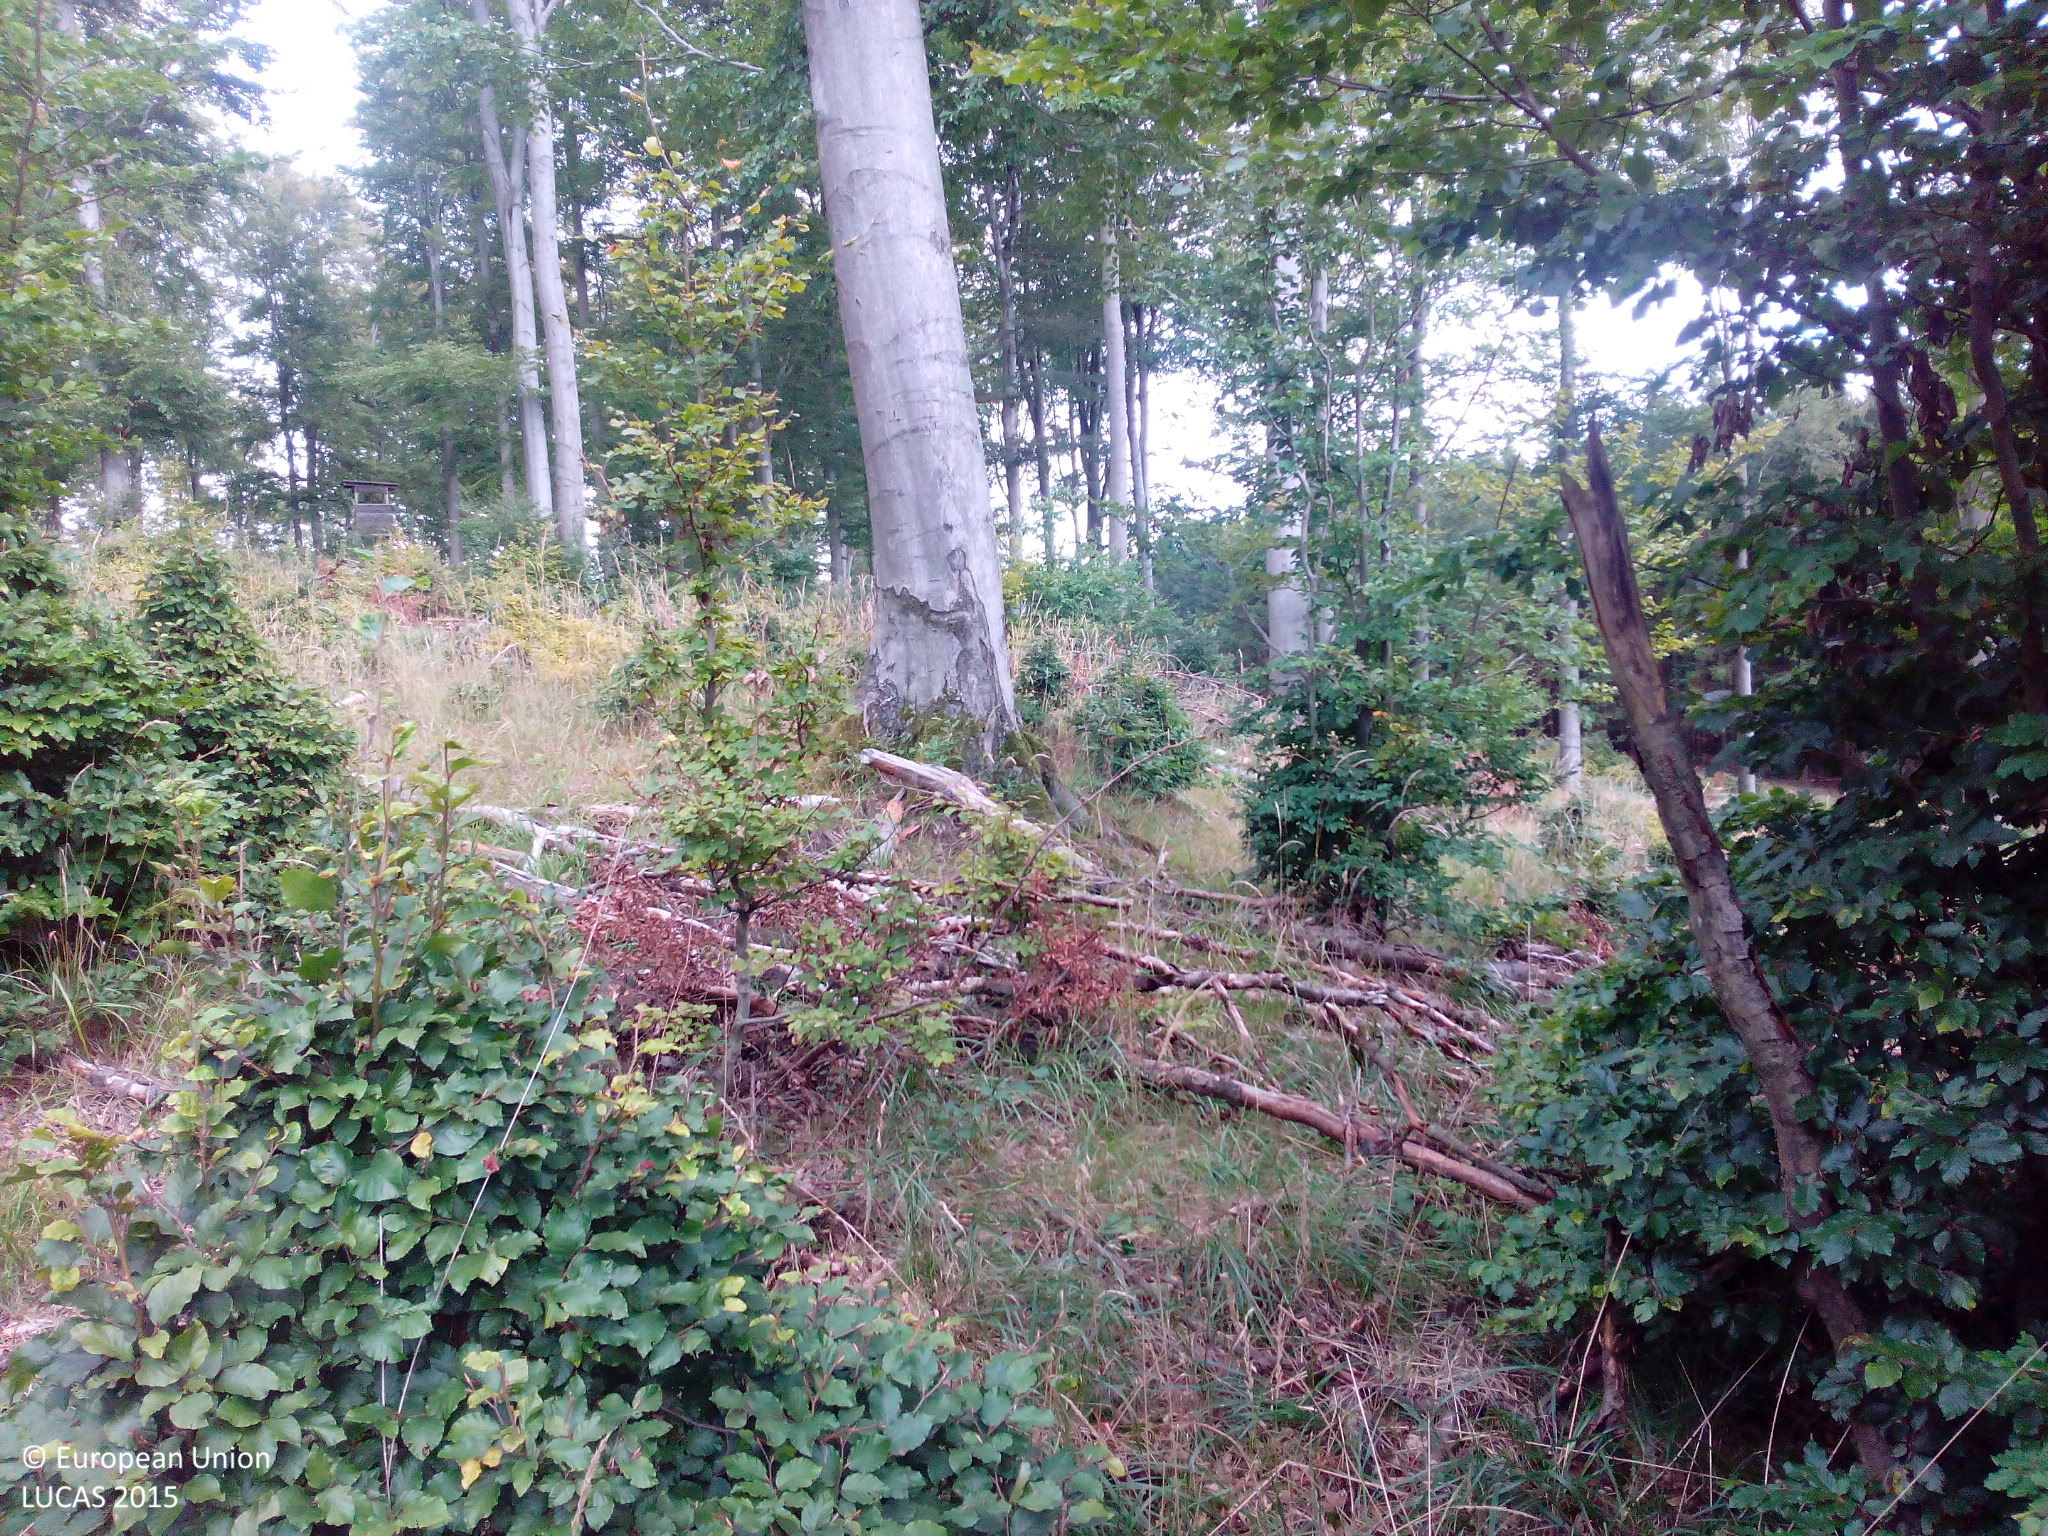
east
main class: Woodland
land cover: Broadleaved woodland
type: beech forest
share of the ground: 50 - 75 %
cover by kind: broadleaved forest trees 70 %, herbaceous plants 30 %
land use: Forestry
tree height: > 5 m
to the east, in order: Broadleaved woodland; Grassland with sparse tree/shrub cover; Broadleaved woodland; Tracks; Broadleaved woodland
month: September
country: DE
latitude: 51.6005
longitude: 10.9670
